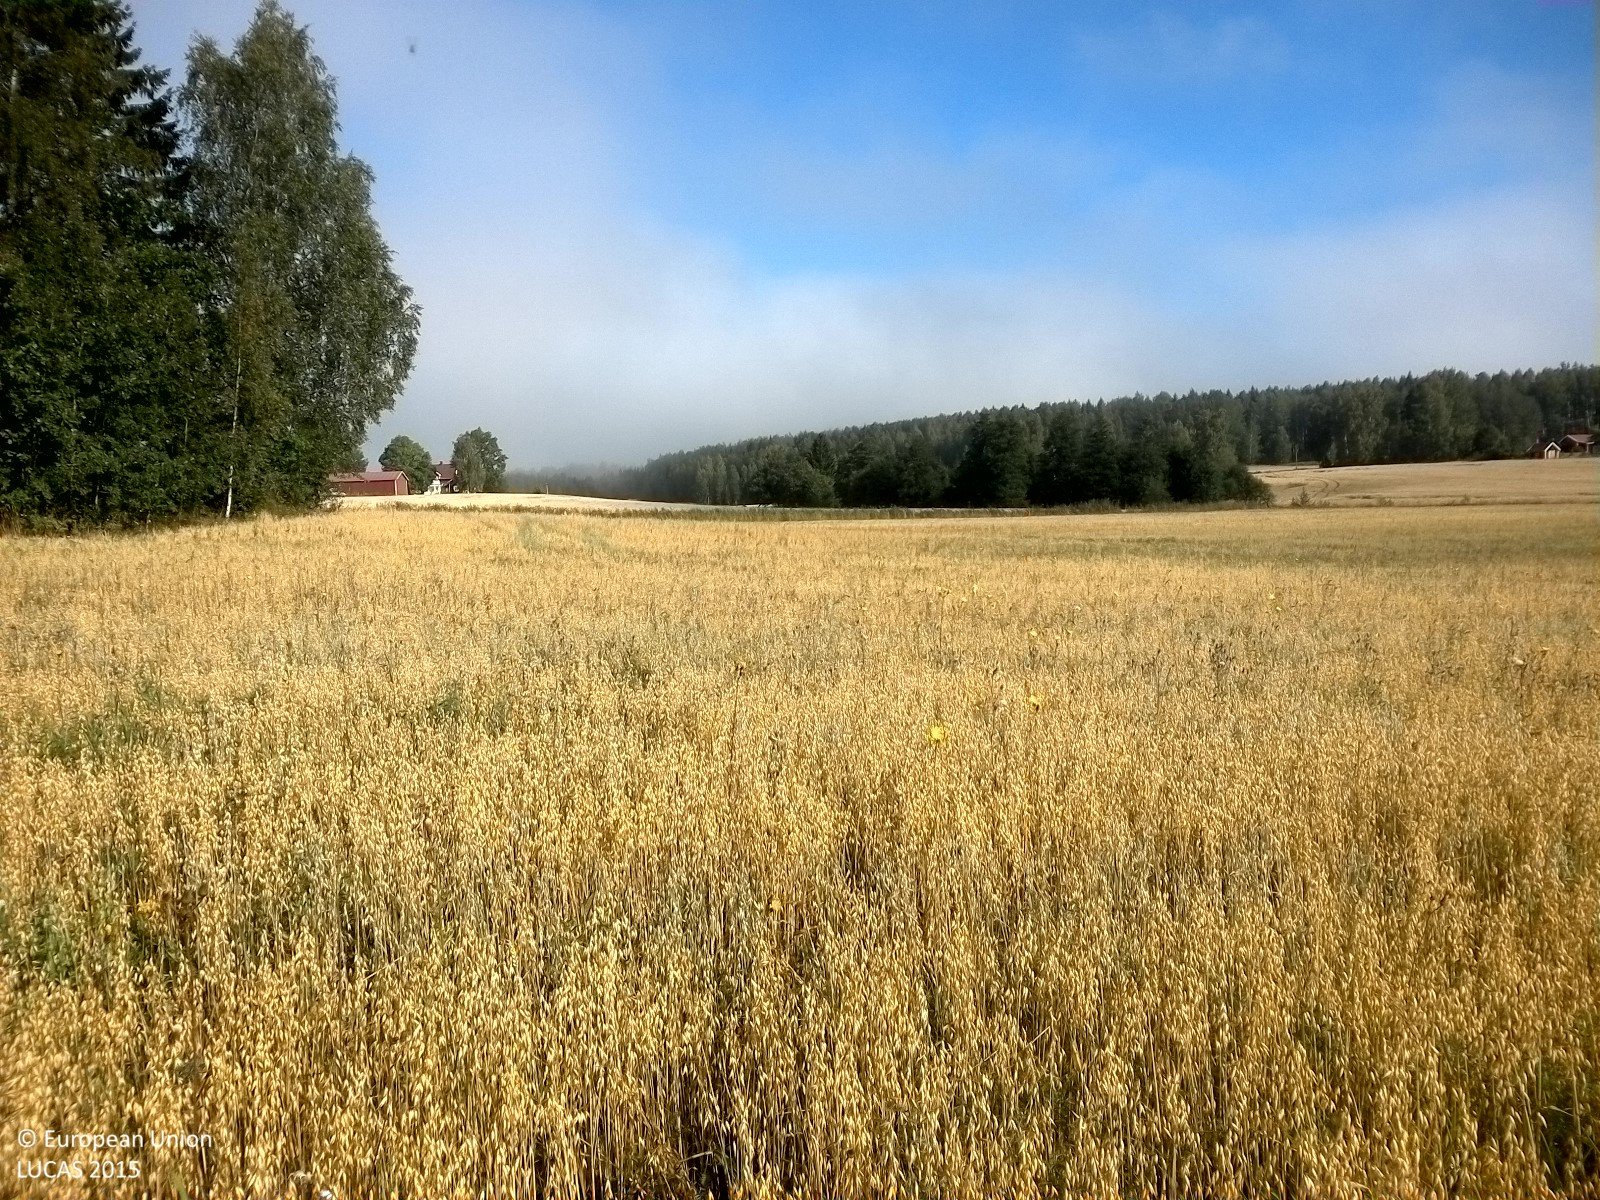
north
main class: Cropland
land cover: Oats
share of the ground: > 75 %
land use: Agriculture (excluding fallow land and kitchen gardens)
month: August
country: SE
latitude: 59.3819
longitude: 15.1841
